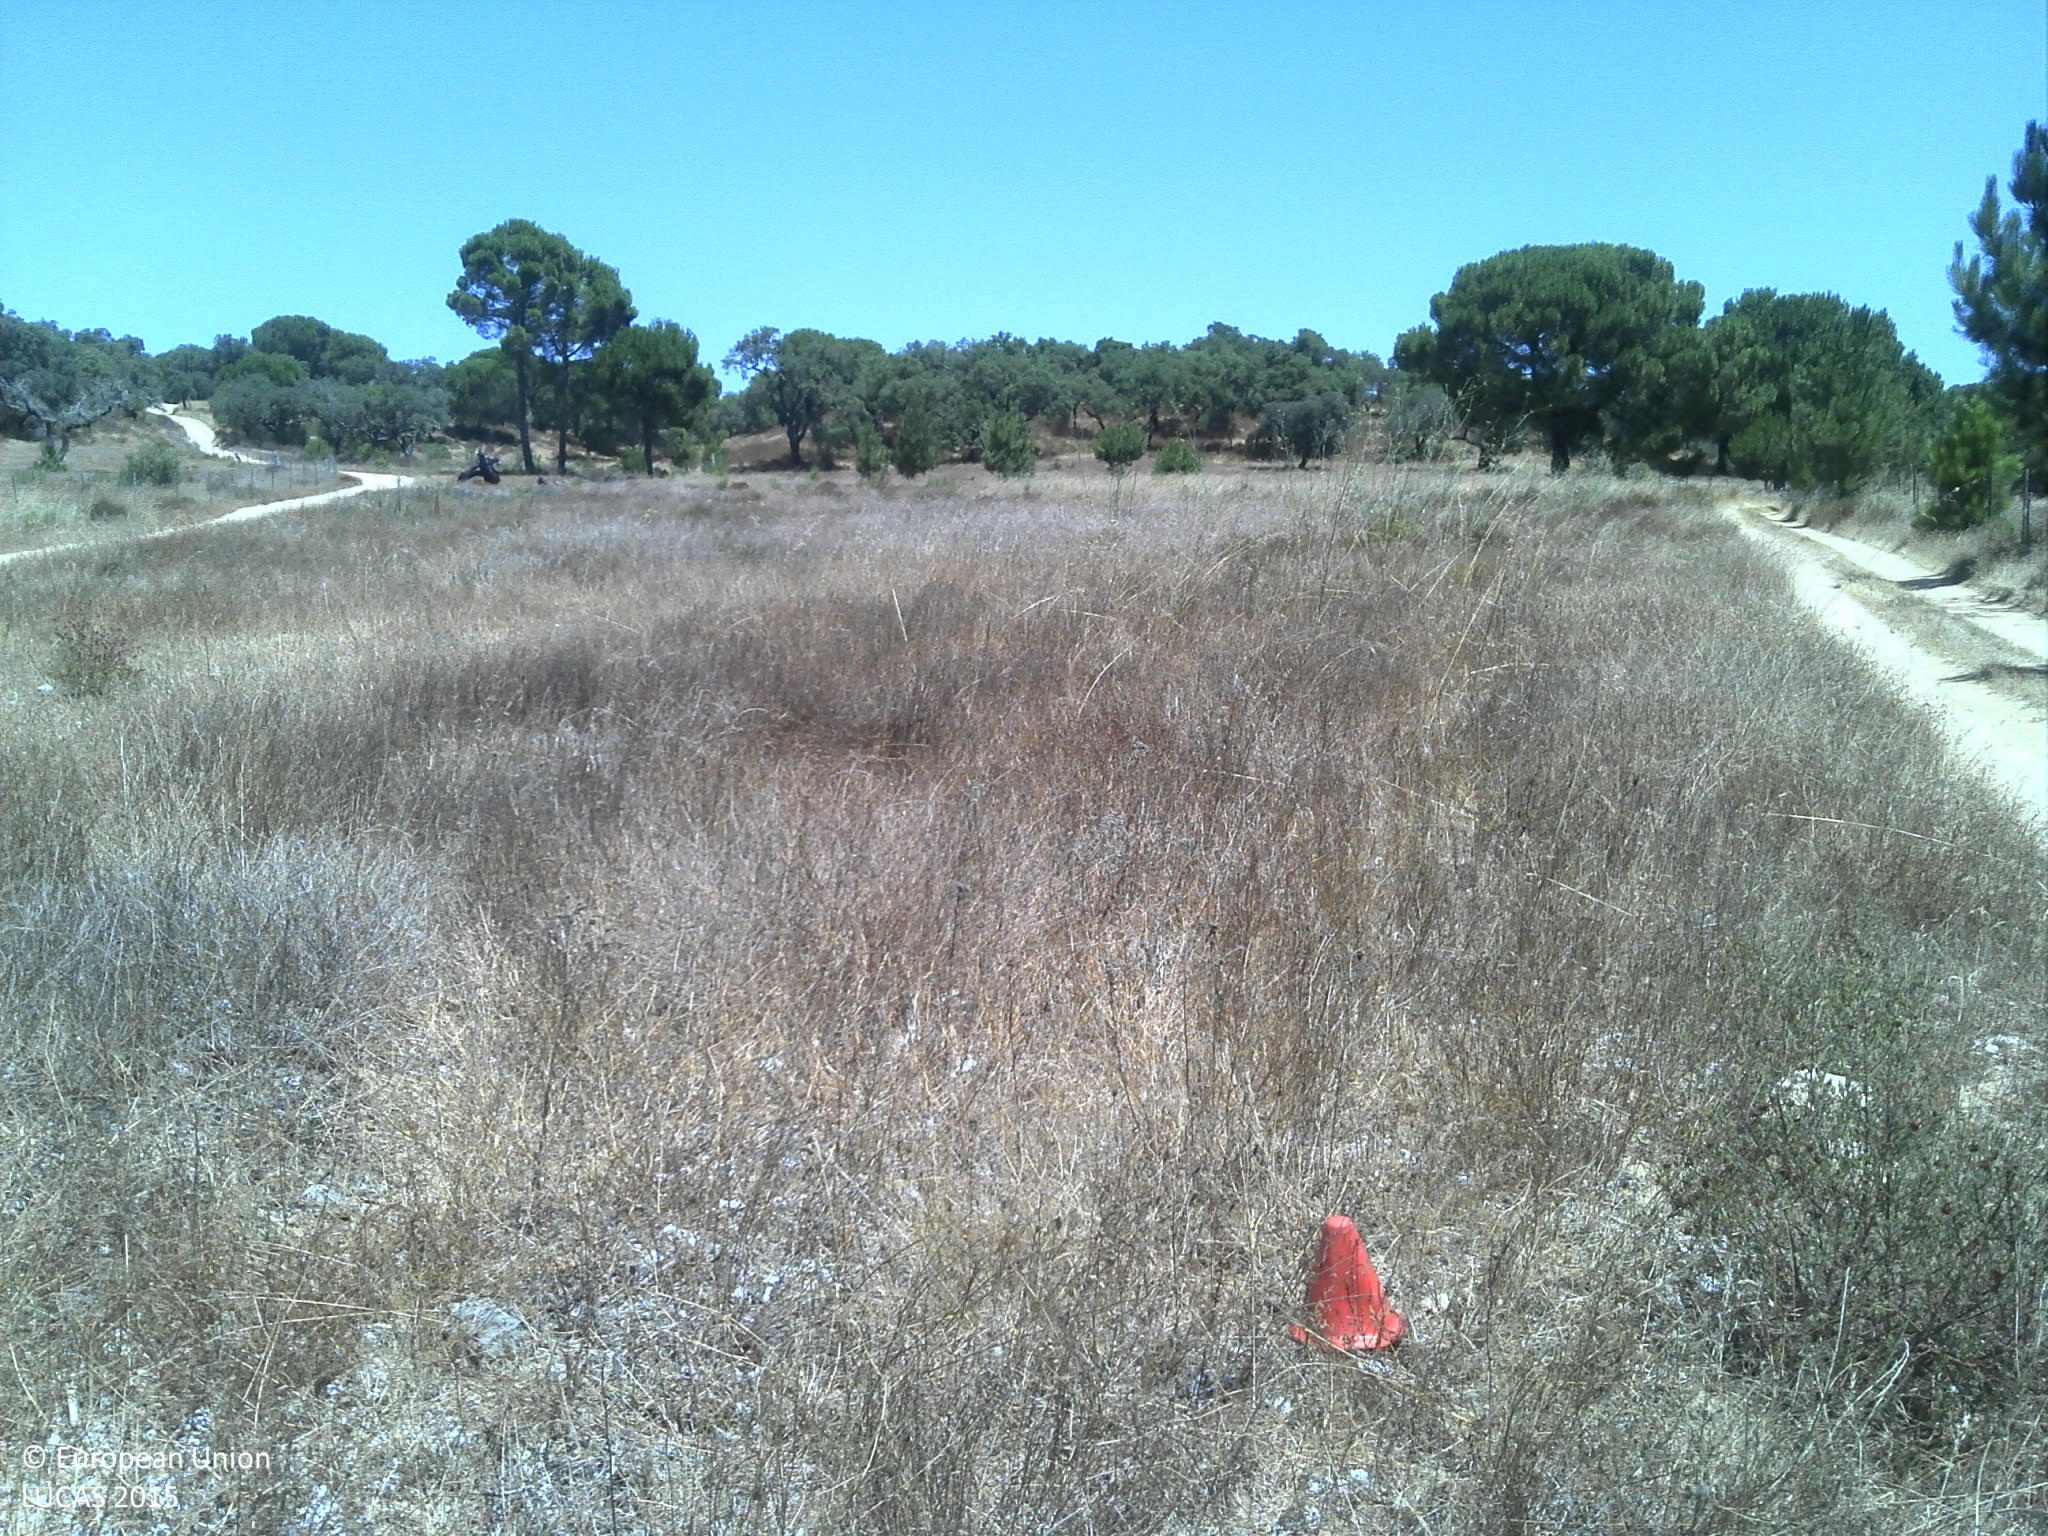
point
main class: Grassland
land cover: Spontaneously vegetated surfaces
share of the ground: 50 - 75 %
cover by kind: herbaceous plants 90 %, unconsolidated bare surface 10 %
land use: Fallow land
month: July
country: PT
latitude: 38.9985
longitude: -8.2654
